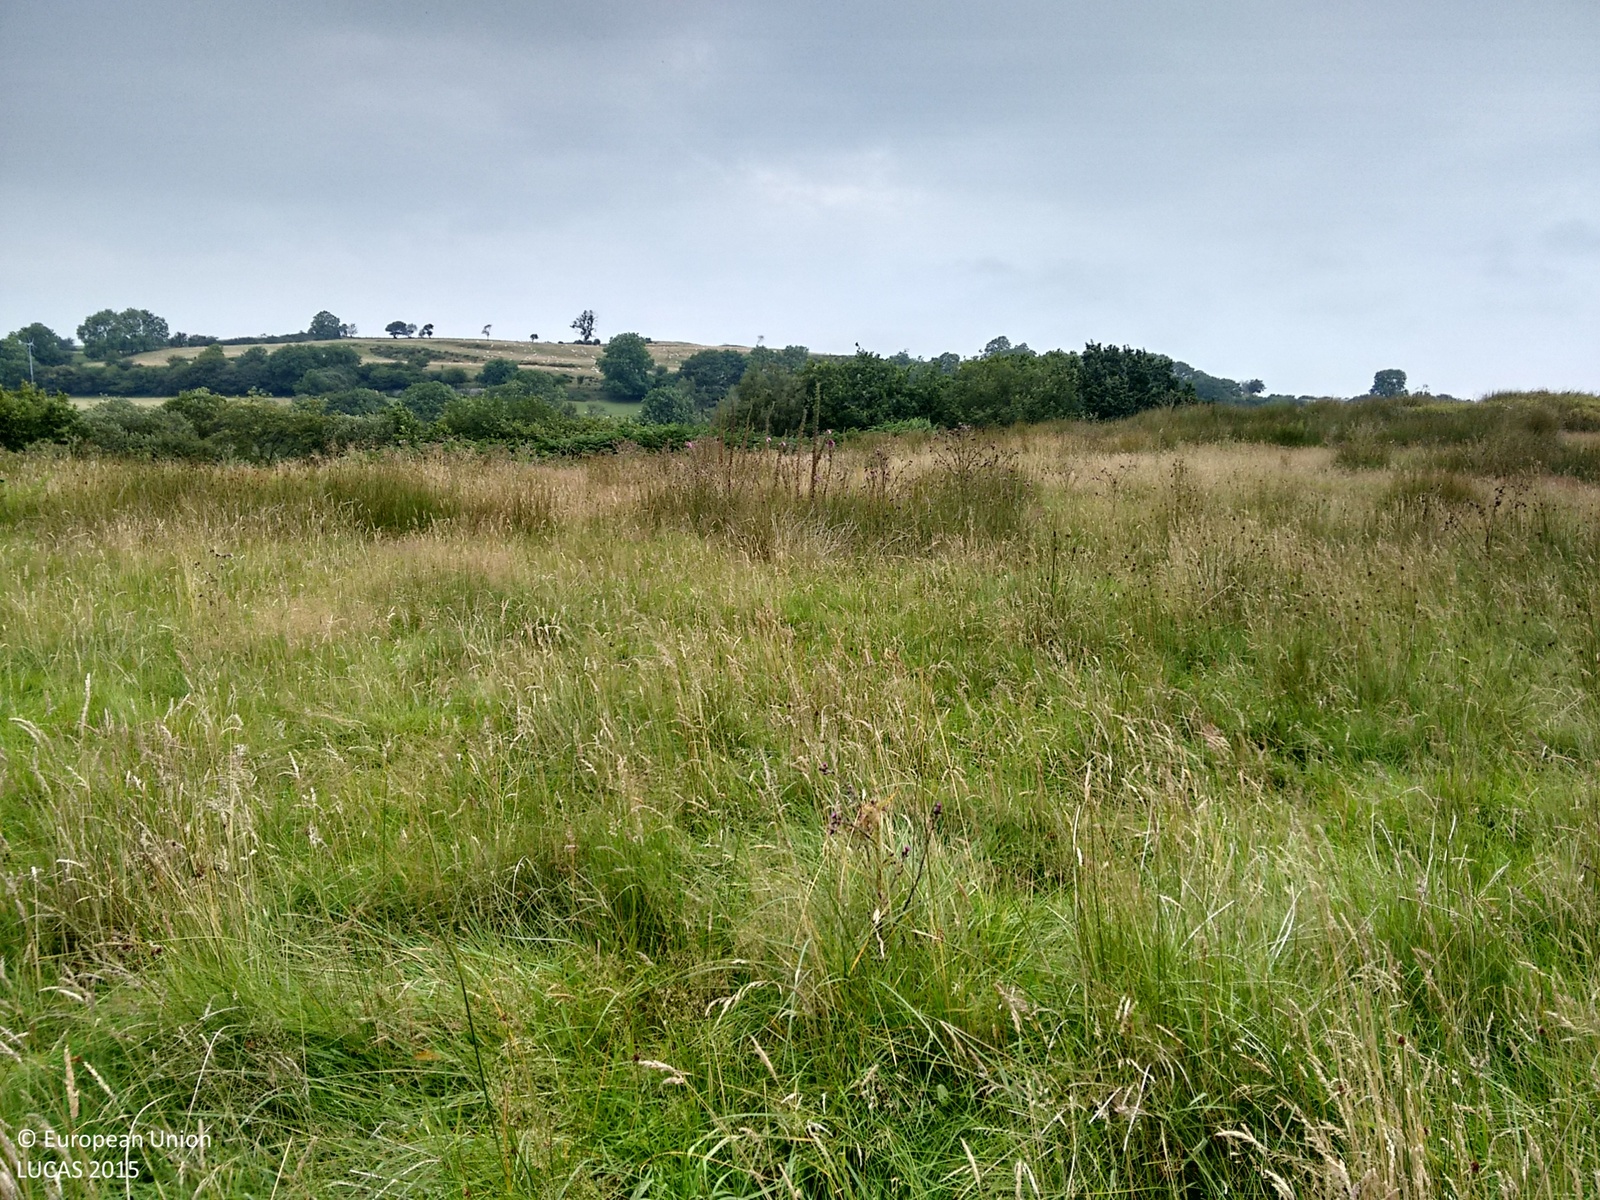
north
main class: Grassland
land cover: Grassland without tree/shrub cover
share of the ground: > 75 %
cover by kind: herbaceous plants 100 %
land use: Agriculture (excluding fallow land and kitchen gardens)
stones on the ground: < 10 %
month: August
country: GB
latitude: 52.0085
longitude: -3.9185
